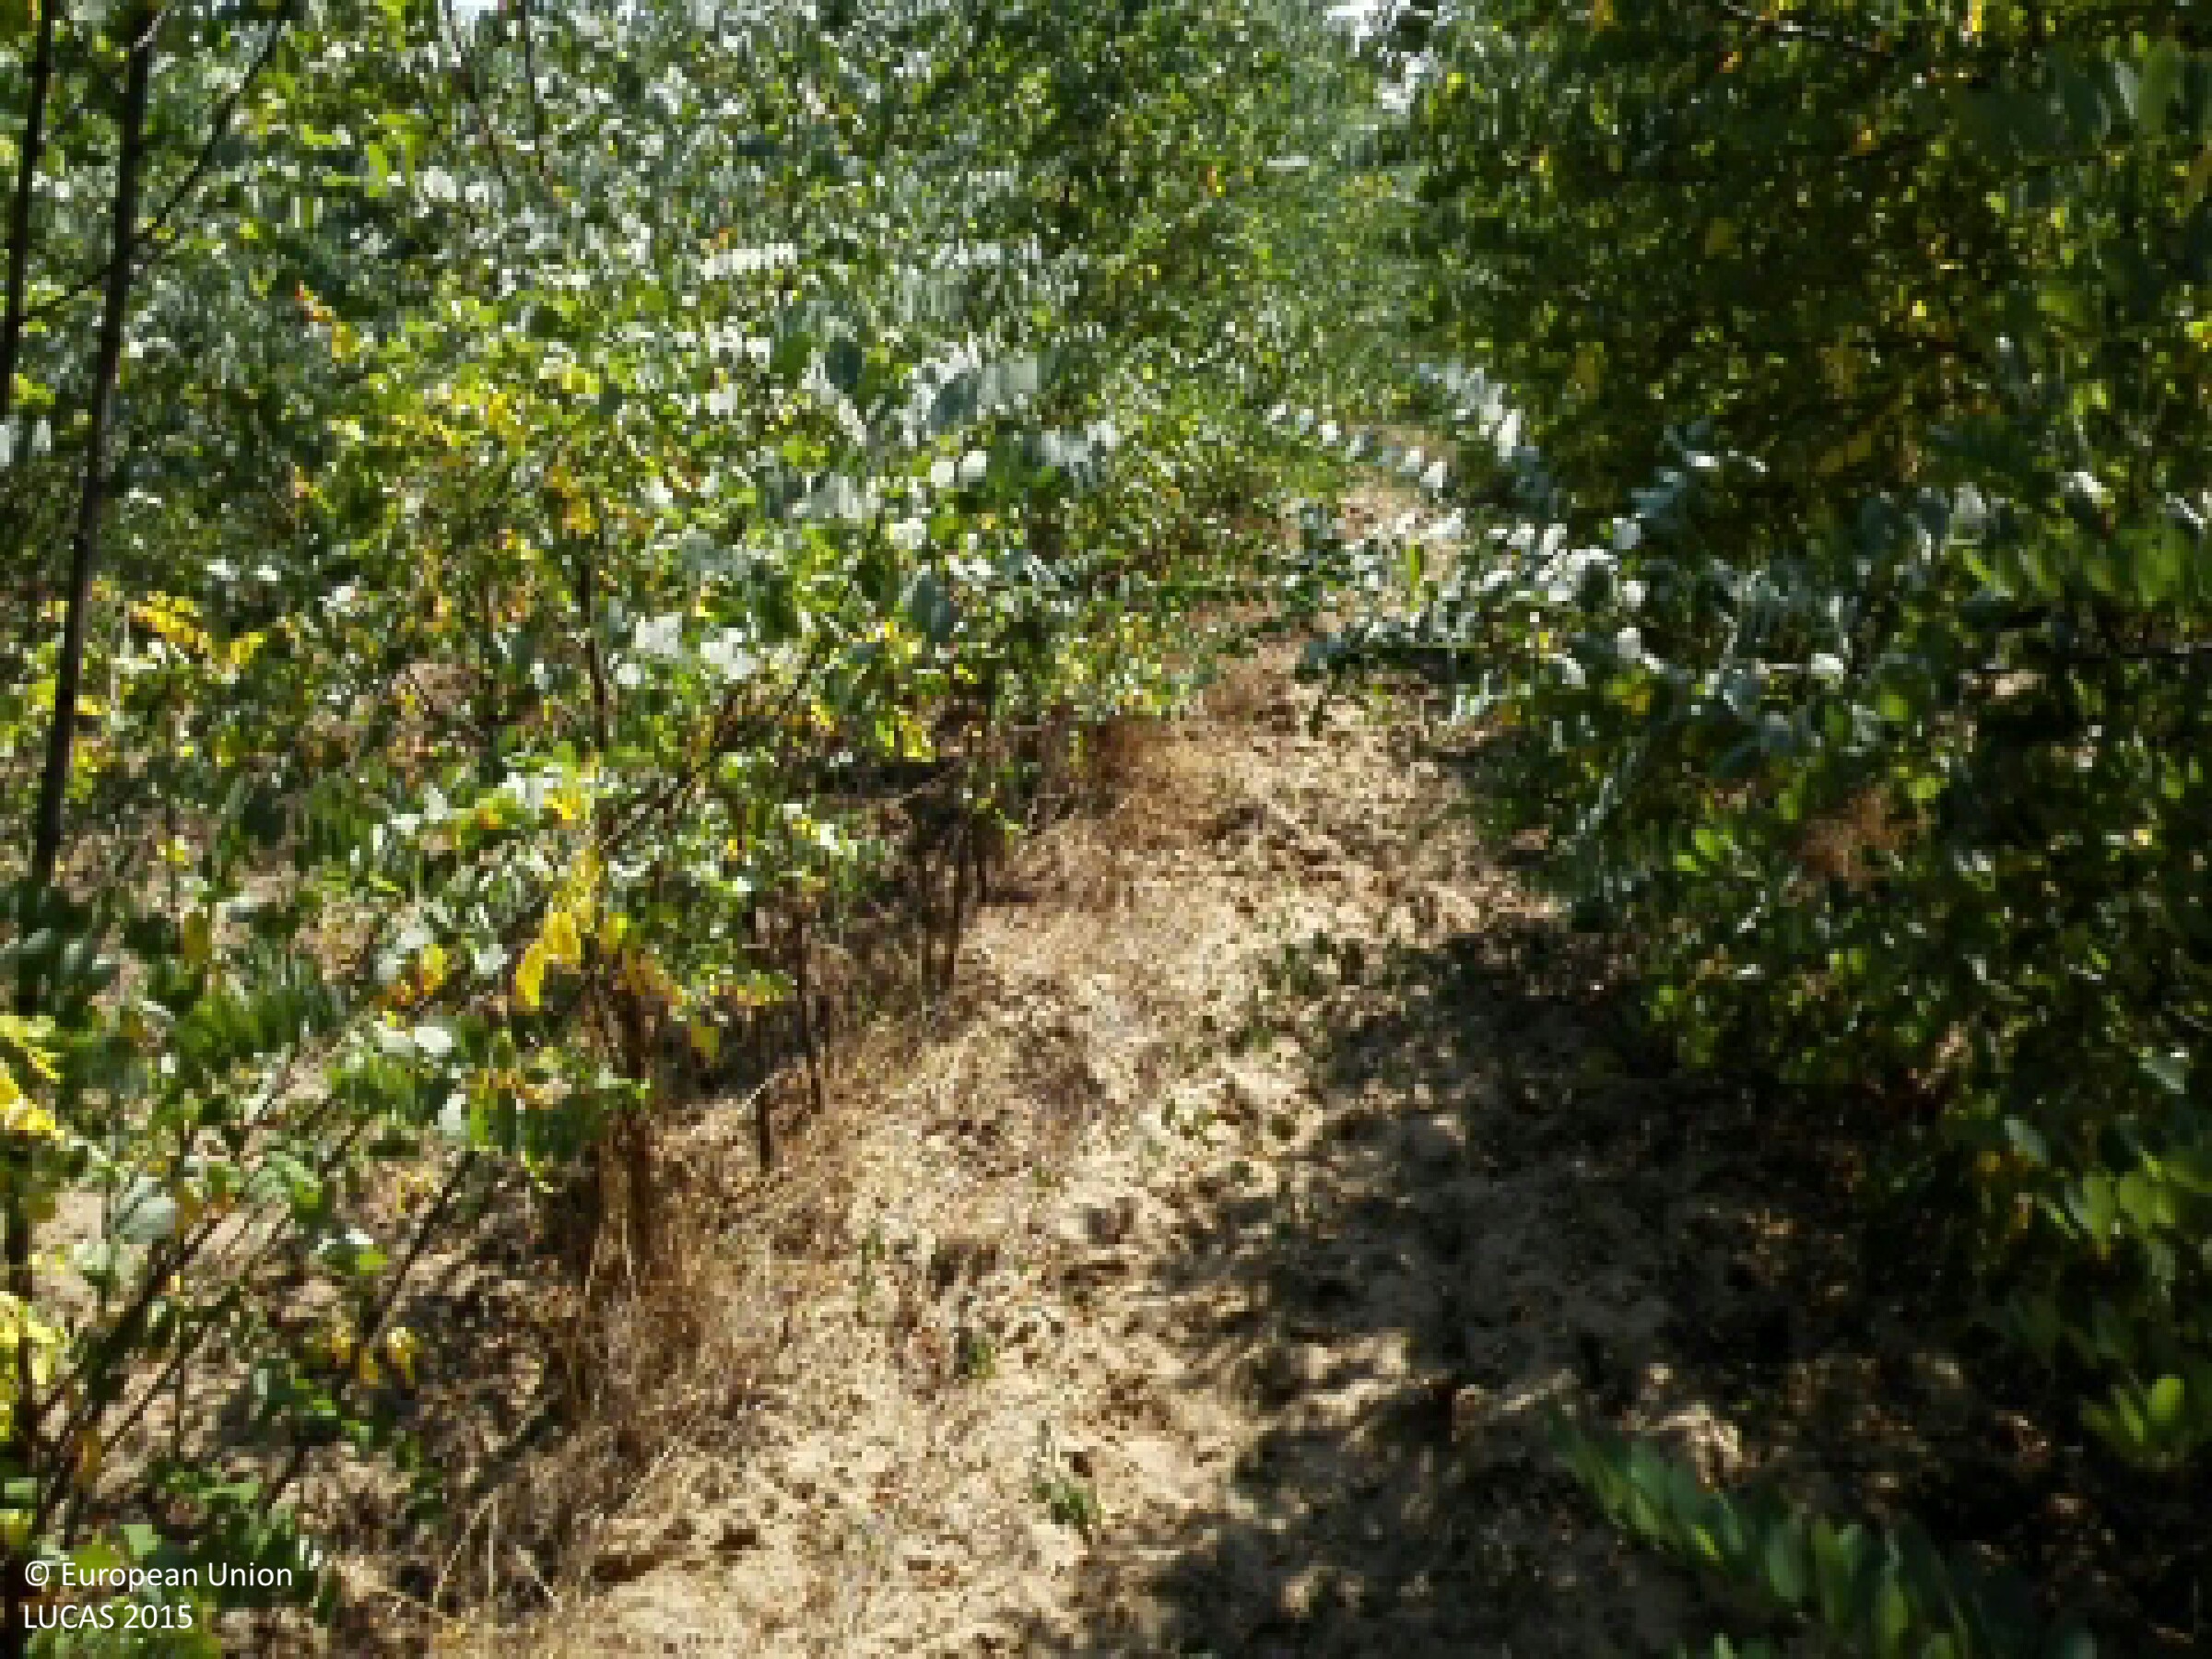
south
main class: Woodland
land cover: Broadleaved woodland
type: thermophilous deciduous forest
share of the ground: > 75 %
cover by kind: broadleaved forest trees 100 %
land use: Forestry
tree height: < 5 m
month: July
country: HU
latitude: 47.6205
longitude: 21.6613
